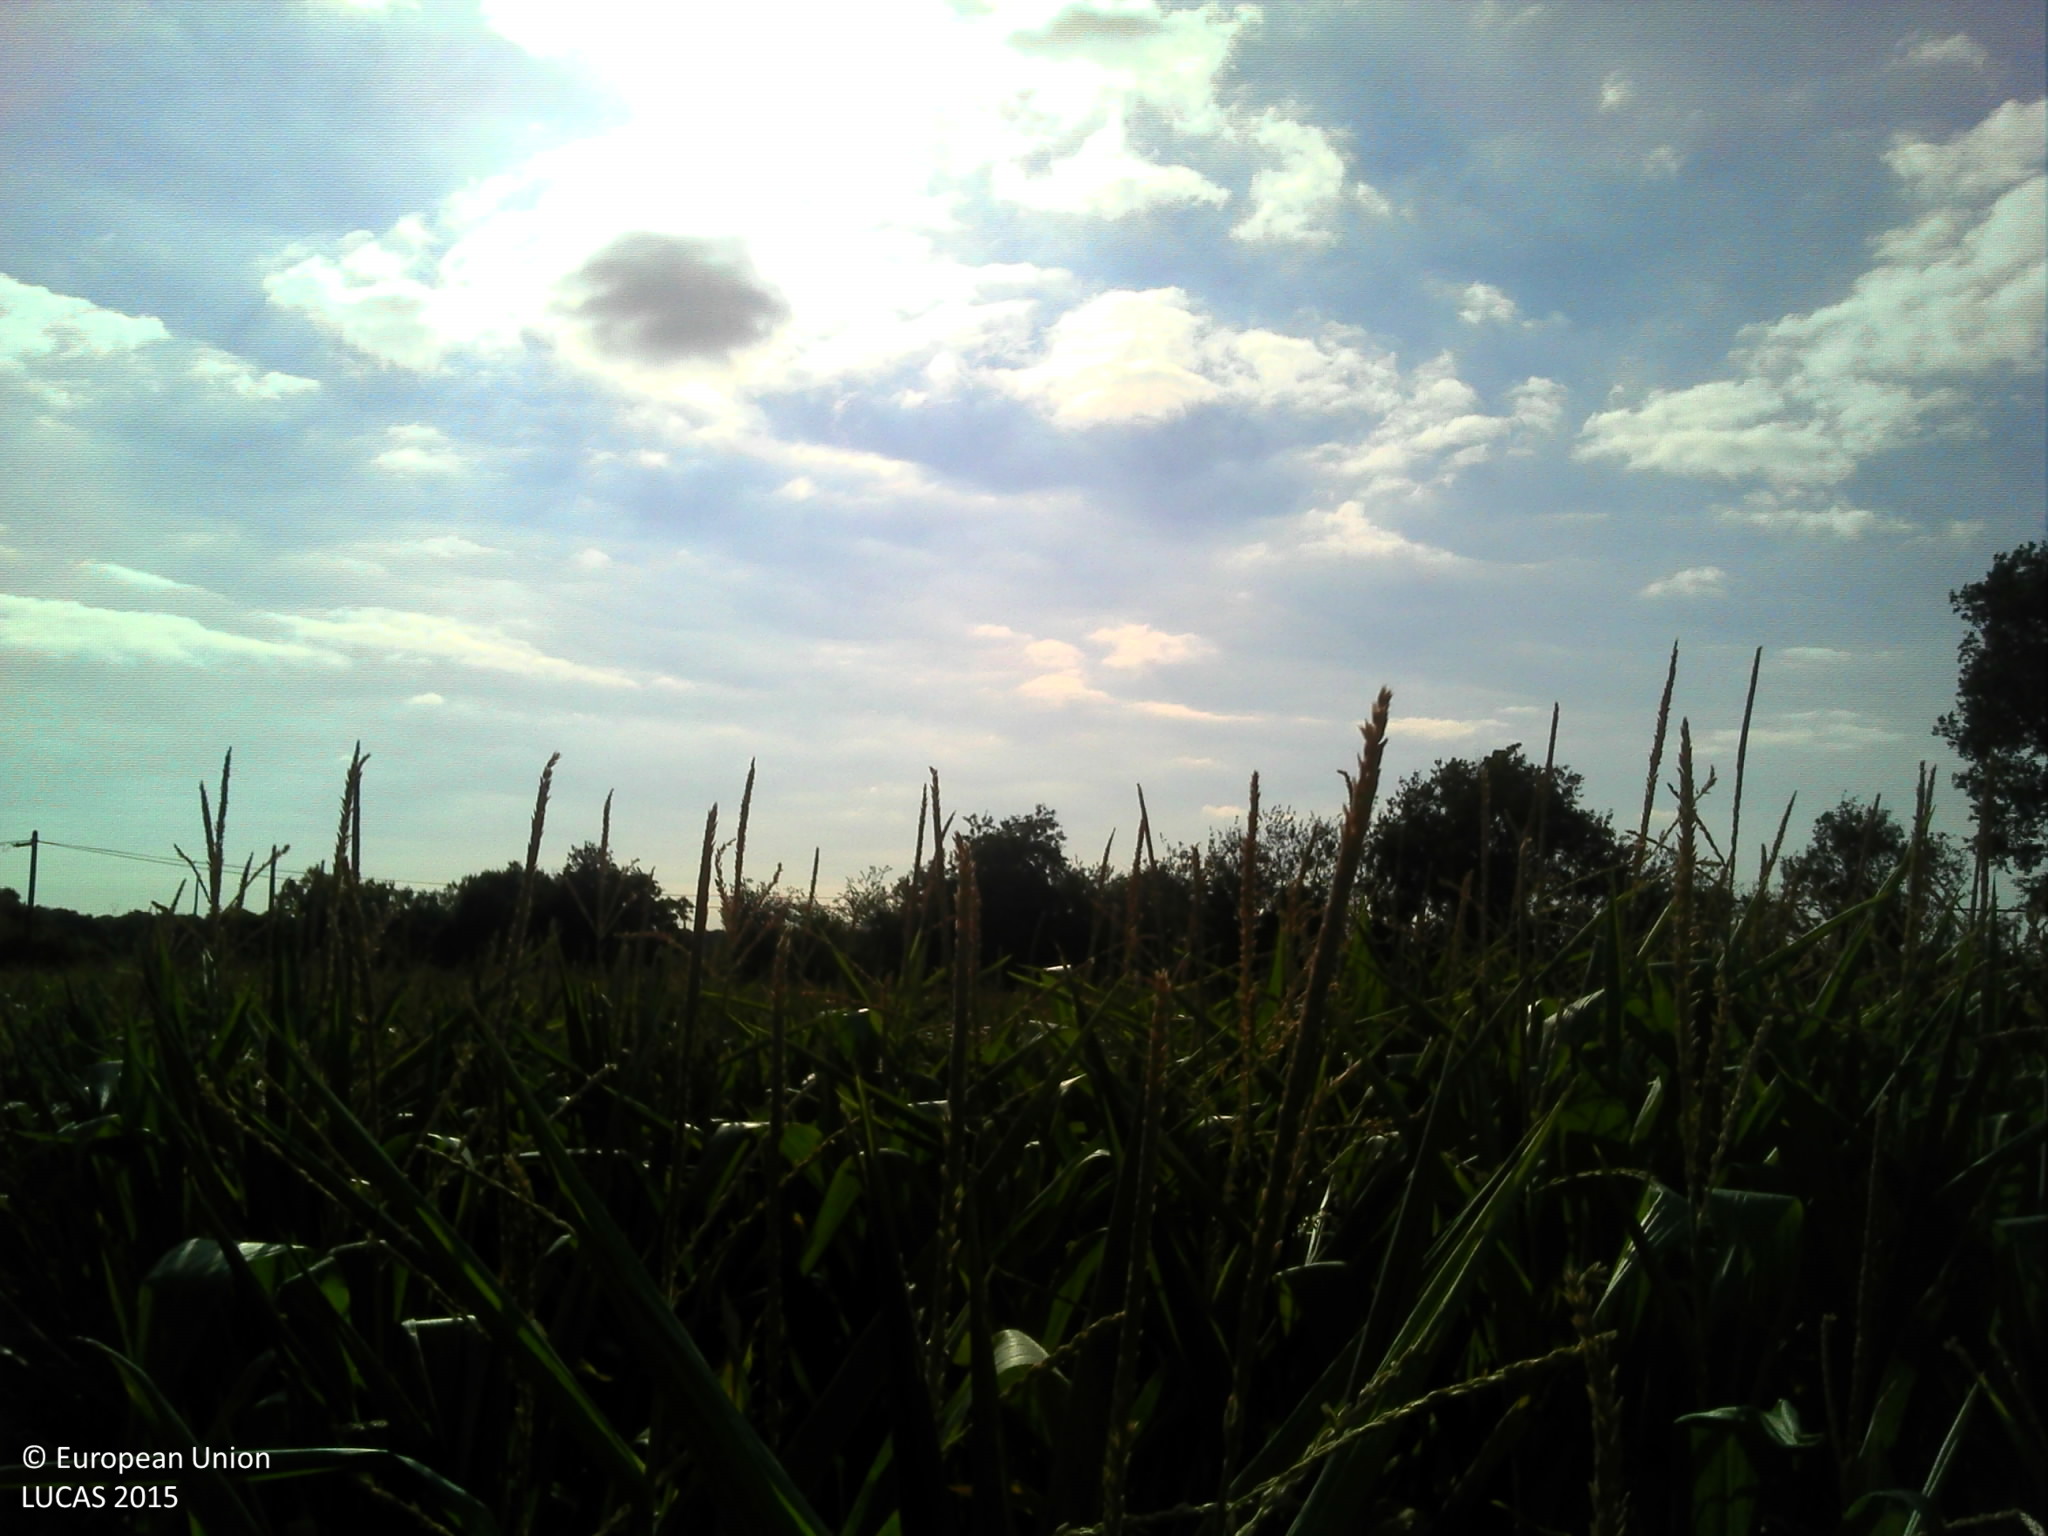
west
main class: Cropland
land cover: Maize
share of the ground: > 75 %
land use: Agriculture (excluding fallow land and kitchen gardens)
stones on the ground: 10 - 25 %
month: August
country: FR
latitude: 46.6577
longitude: -1.3141
